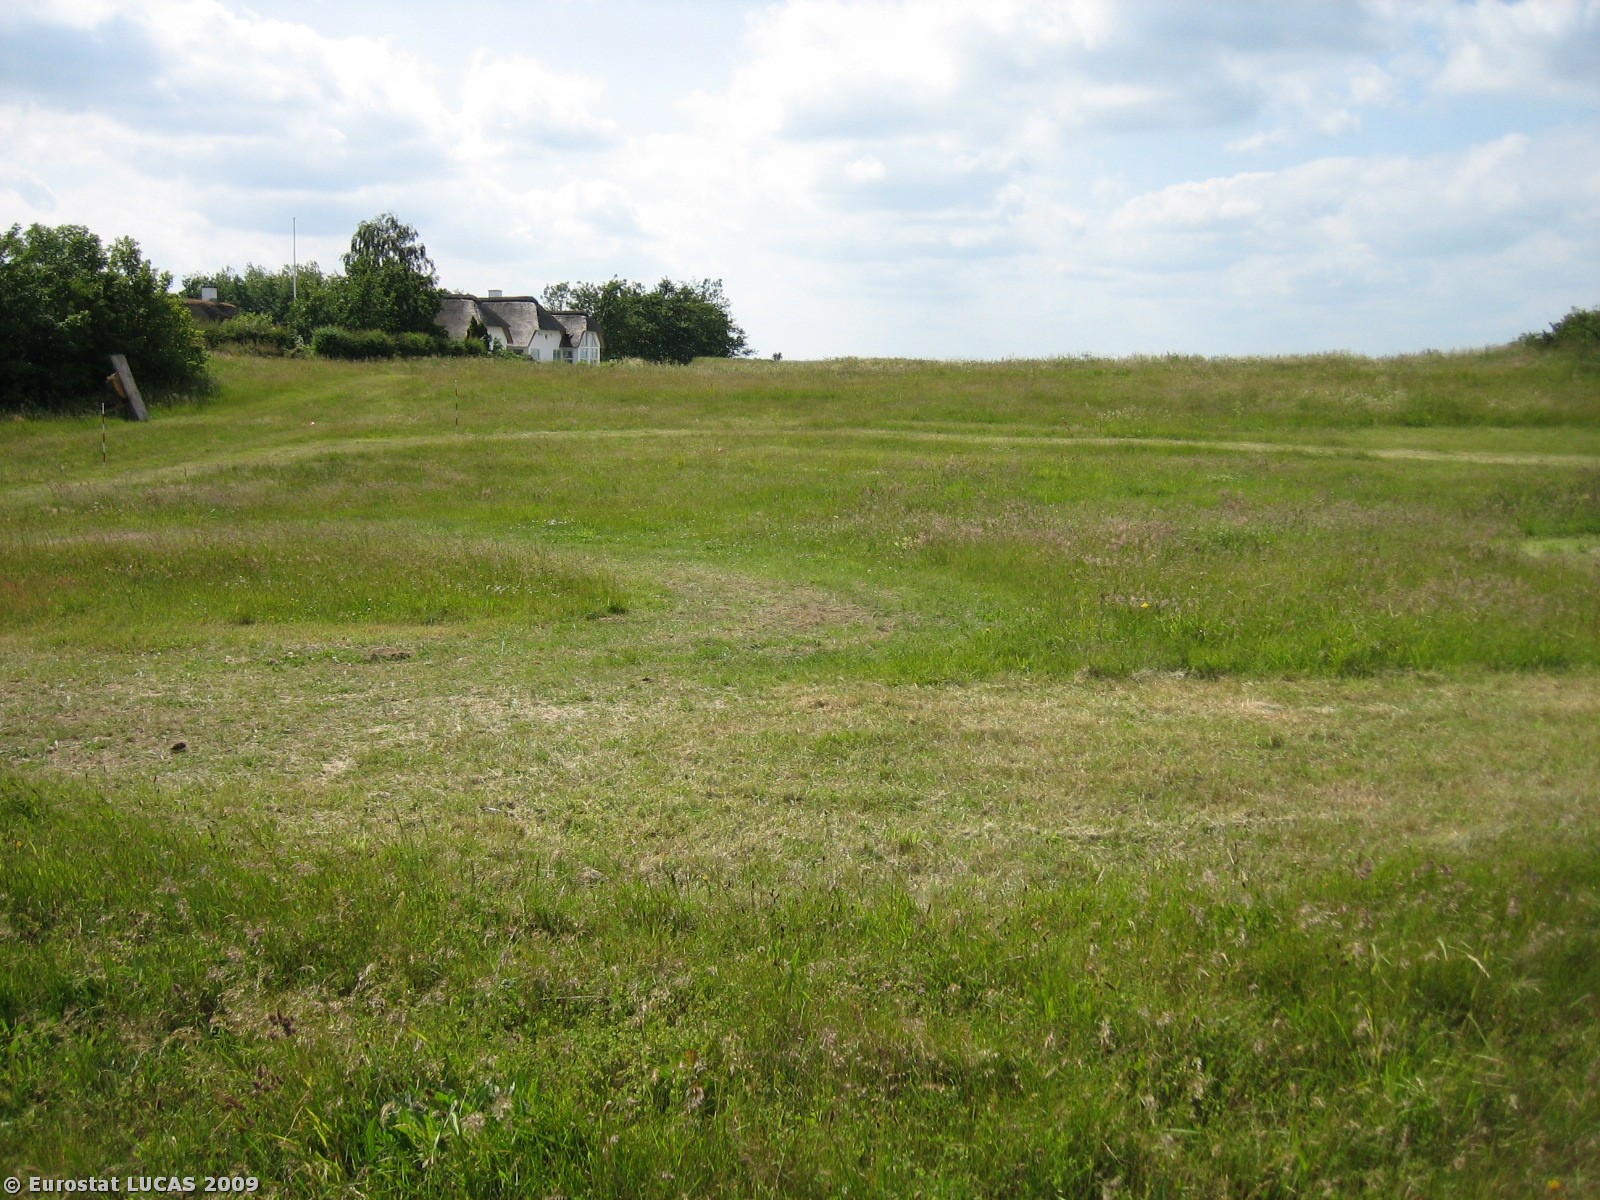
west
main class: Grassland
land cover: Grassland without tree/shrub cover
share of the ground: > 75 %
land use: Amenities, museums, leisure
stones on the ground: 25 - 50 %
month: June
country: DK
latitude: 55.8282
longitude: 10.0160
